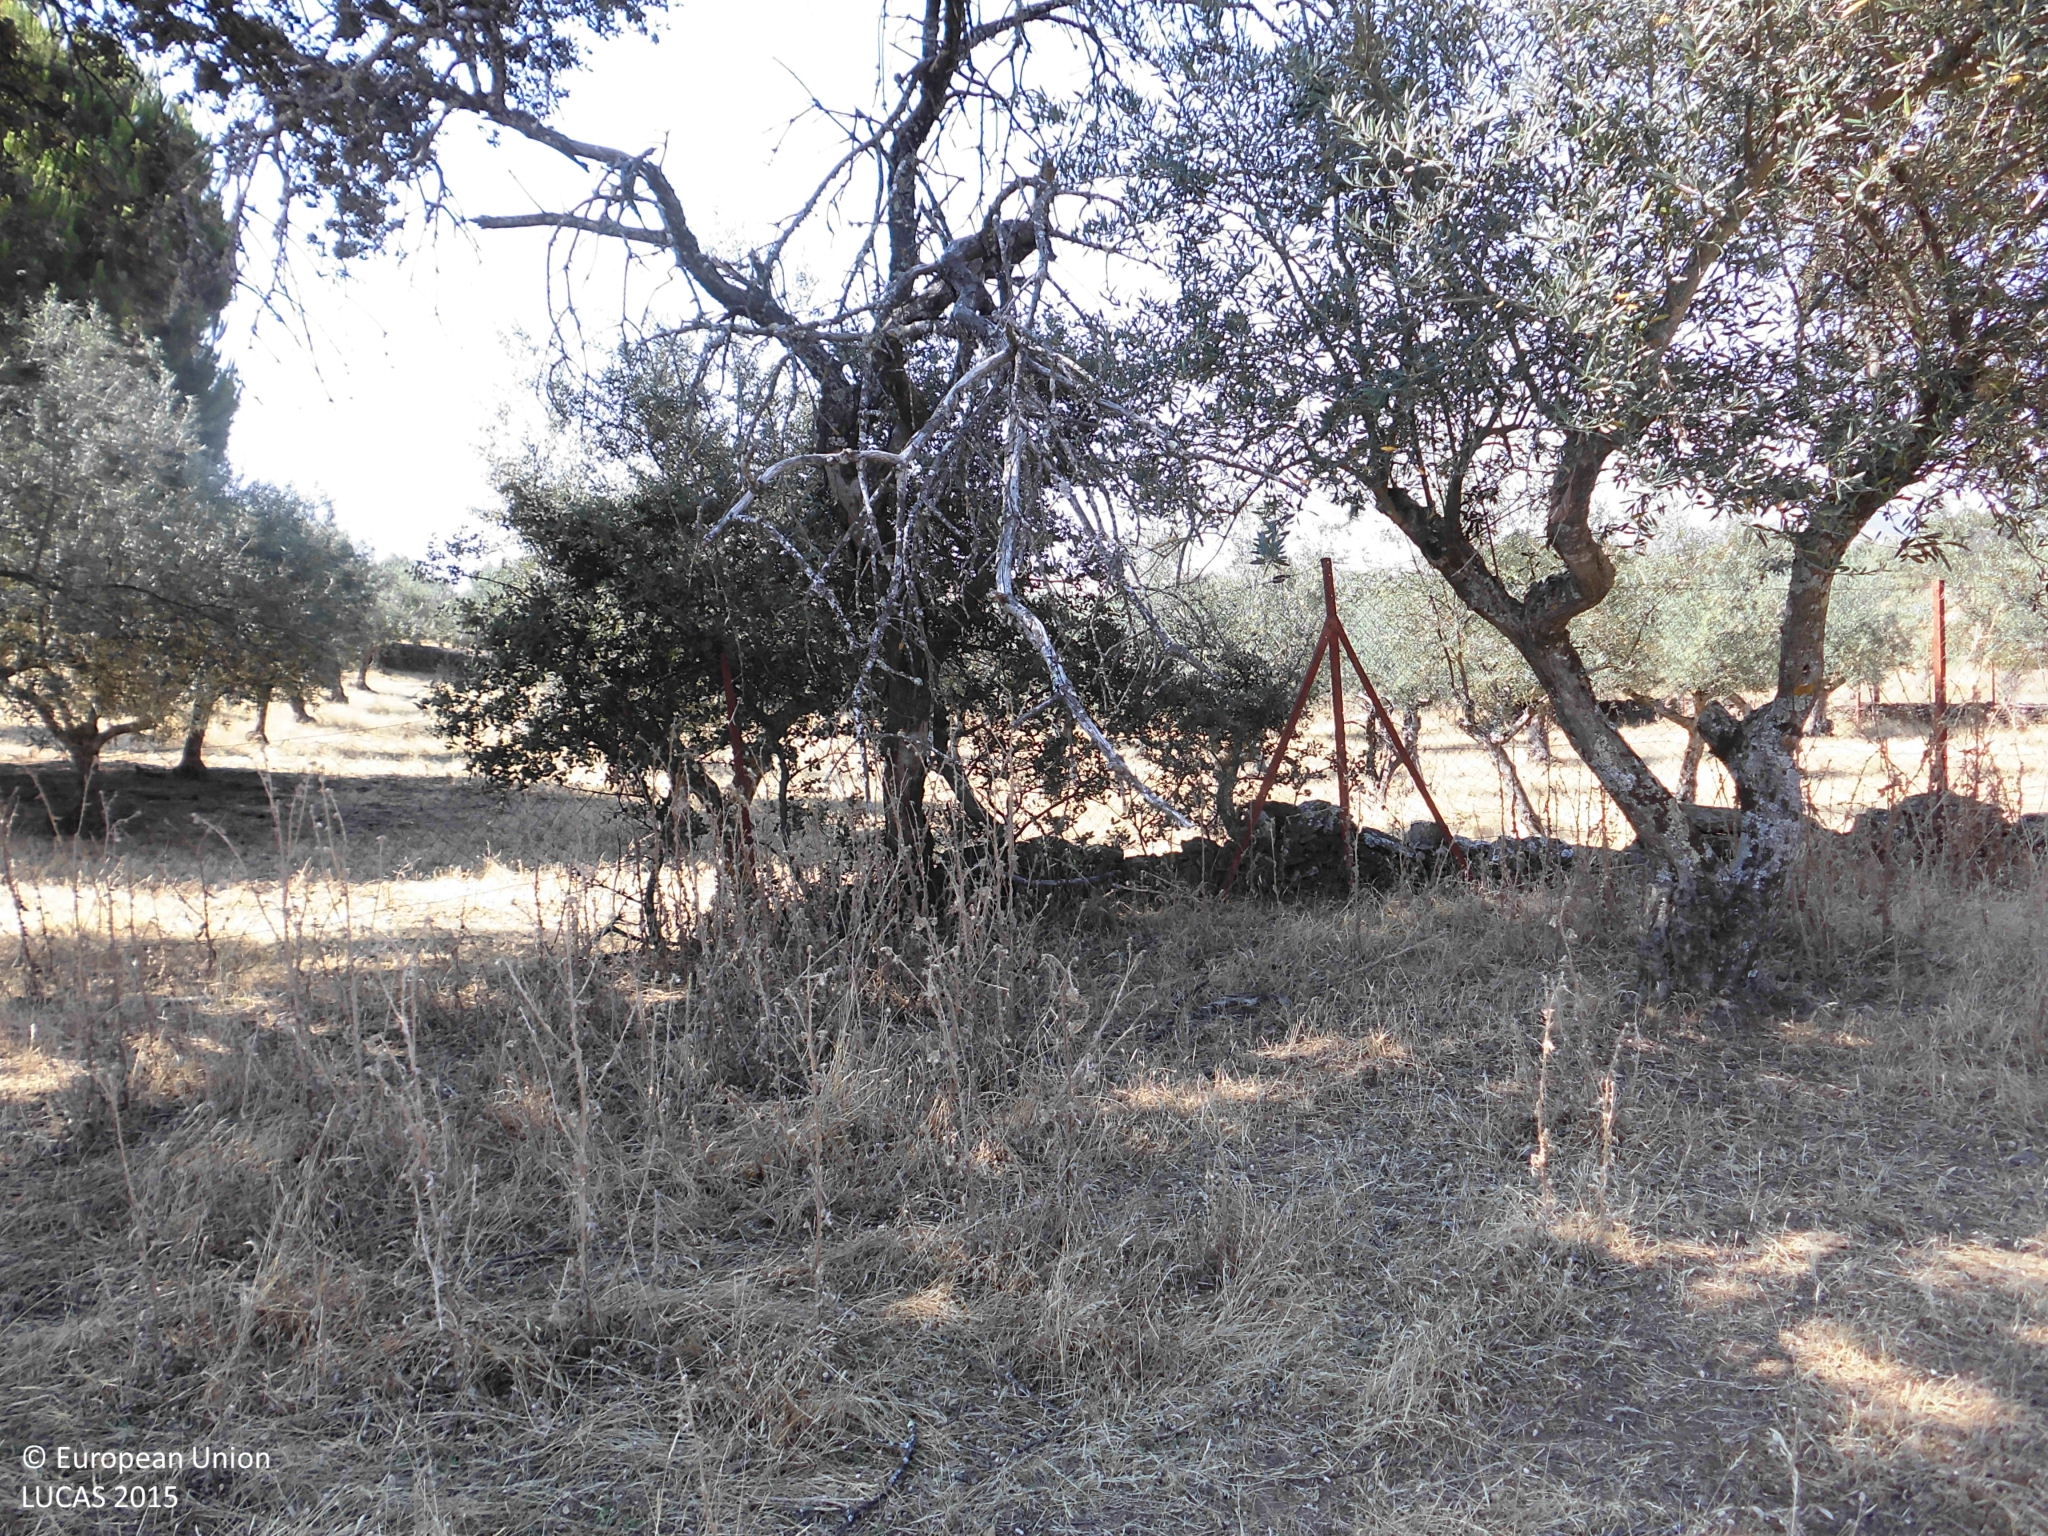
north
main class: Cropland
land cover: Olive groves
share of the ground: 10 - 25 %
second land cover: Grassland without tree/shrub cover
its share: > 75 %
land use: Agriculture (excluding fallow land and kitchen gardens)
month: June
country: ES
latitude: 39.4026
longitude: -5.7908
